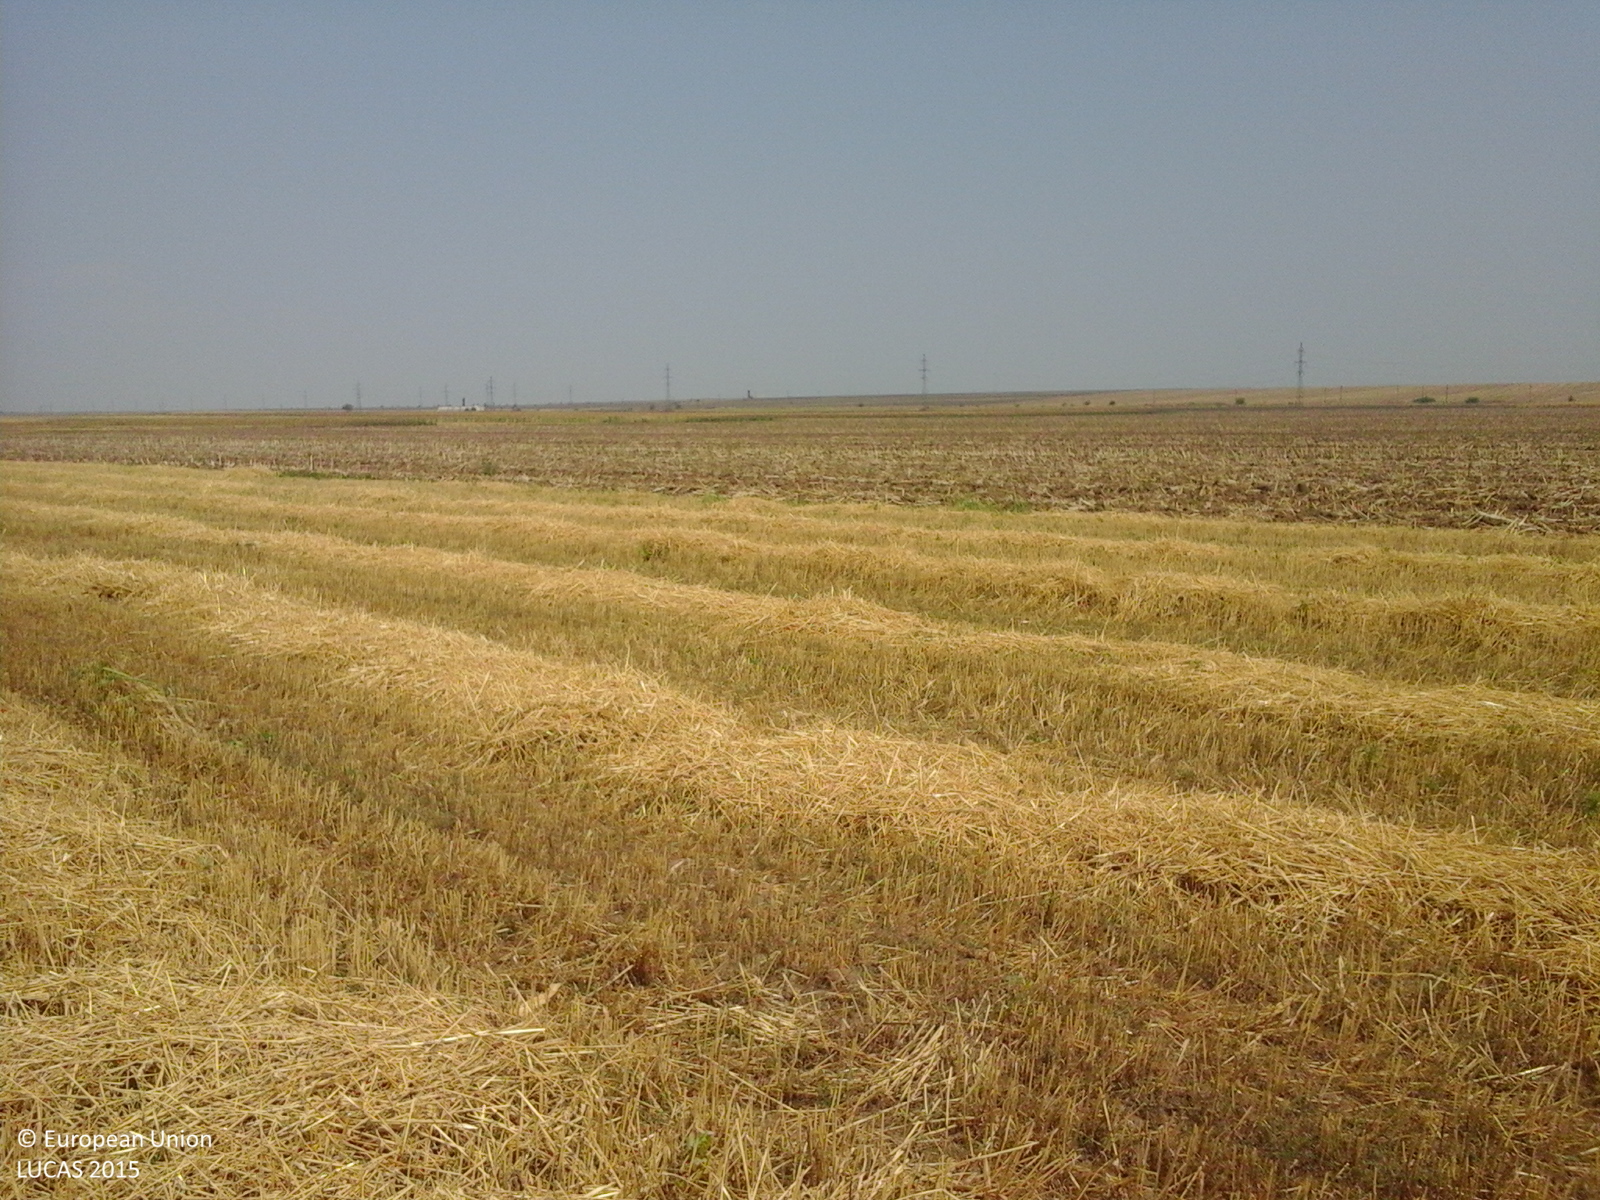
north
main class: Cropland
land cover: Common wheat
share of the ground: > 75 %
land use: Agriculture (excluding fallow land and kitchen gardens)
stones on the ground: < 10 %
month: August
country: RO
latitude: 44.2356
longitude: 22.7481
